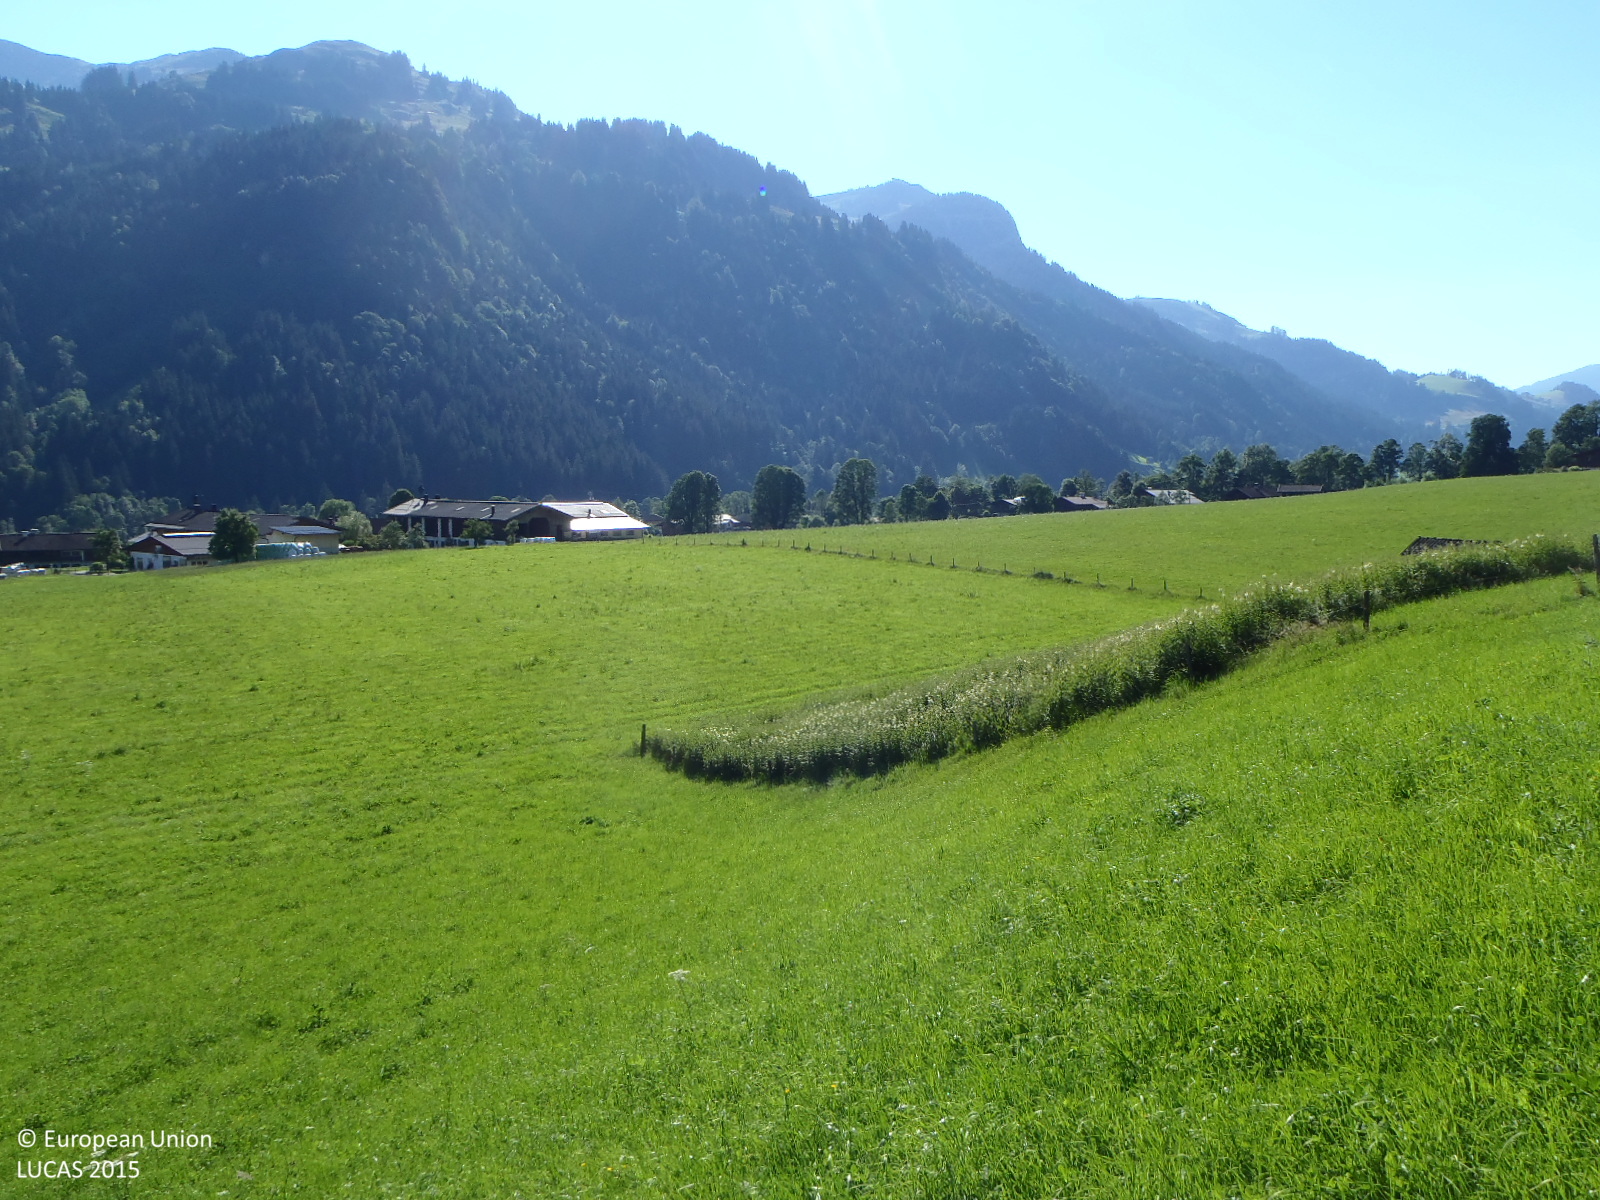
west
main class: Grassland
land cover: Grassland without tree/shrub cover
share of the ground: > 75 %
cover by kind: herbaceous plants 100 %
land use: Agriculture (excluding fallow land and kitchen gardens)
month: July
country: AT
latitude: 47.4226
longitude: 12.4241
